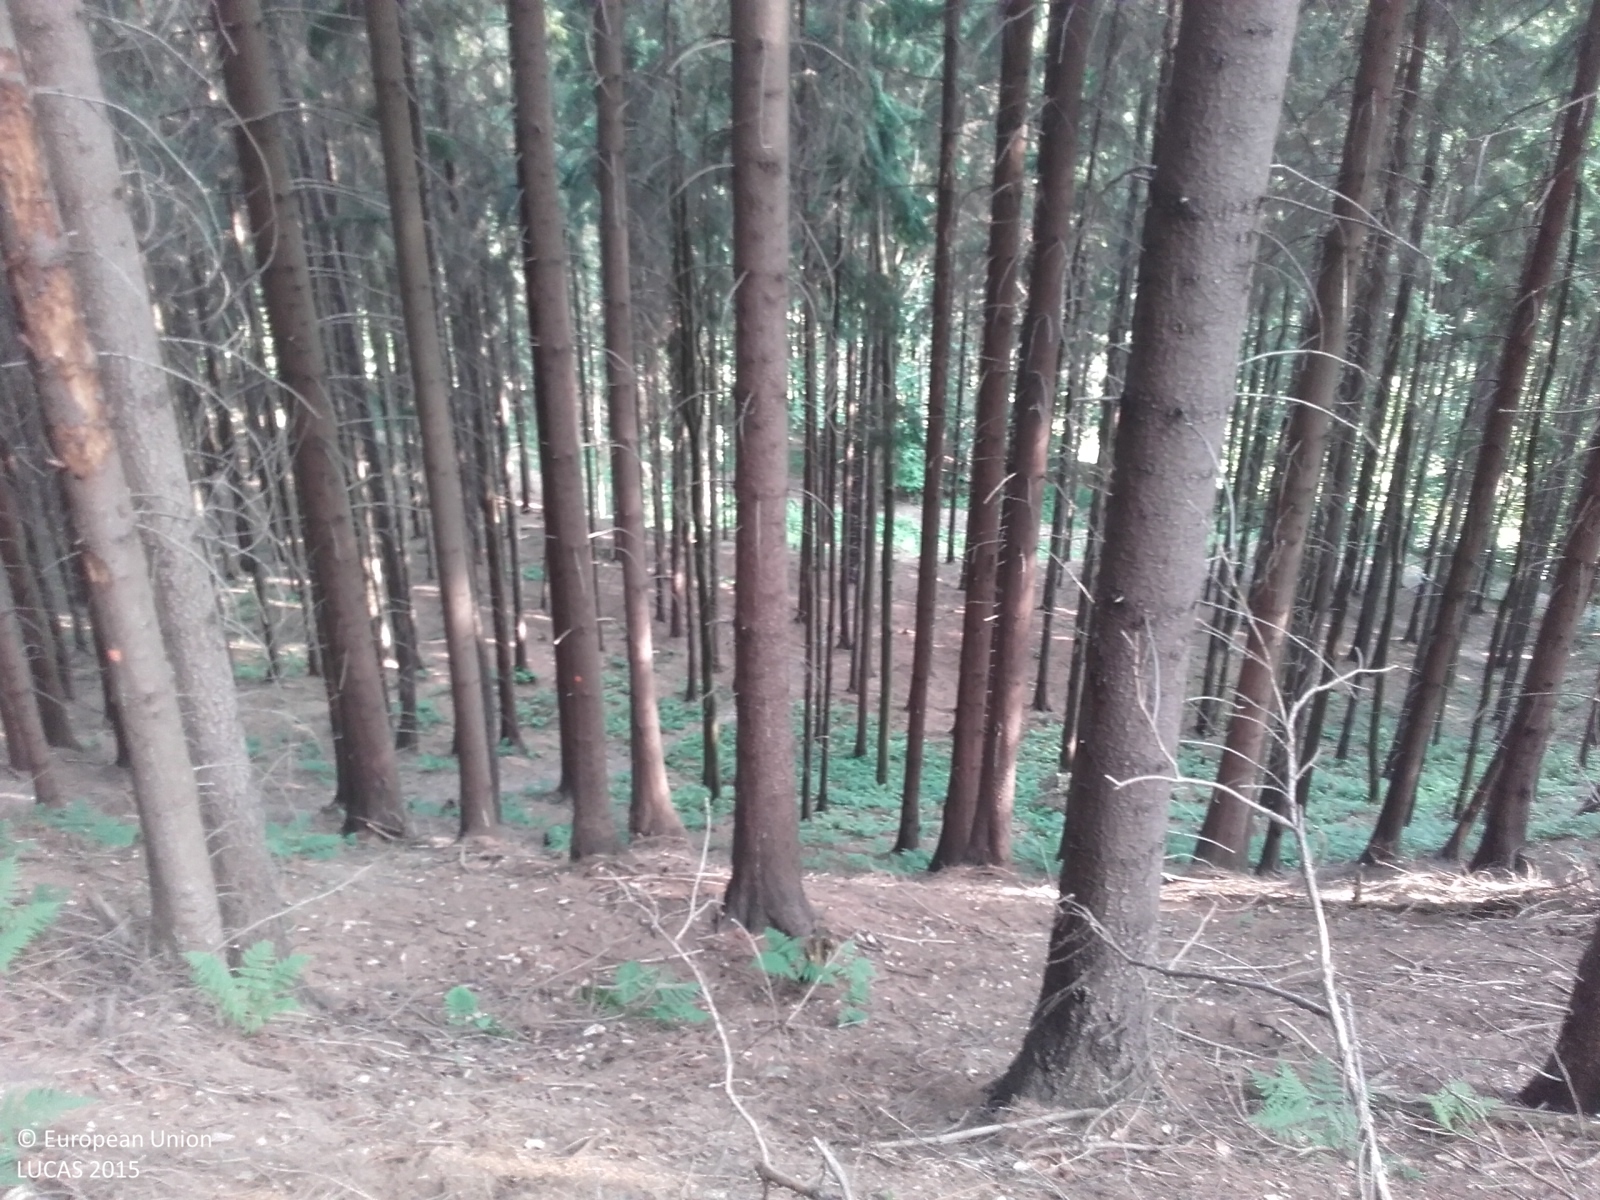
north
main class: Woodland
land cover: Spruce dominated coniferous woodland
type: hemiboreal forest and nemoral coniferous forest and mixed broadleaved-coniferous forest
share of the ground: > 75 %
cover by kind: coniferous forest trees 95 %, herbaceous plants 5 %
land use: Forestry
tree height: > 5 m
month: July
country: CZ
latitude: 49.9711
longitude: 16.3508
